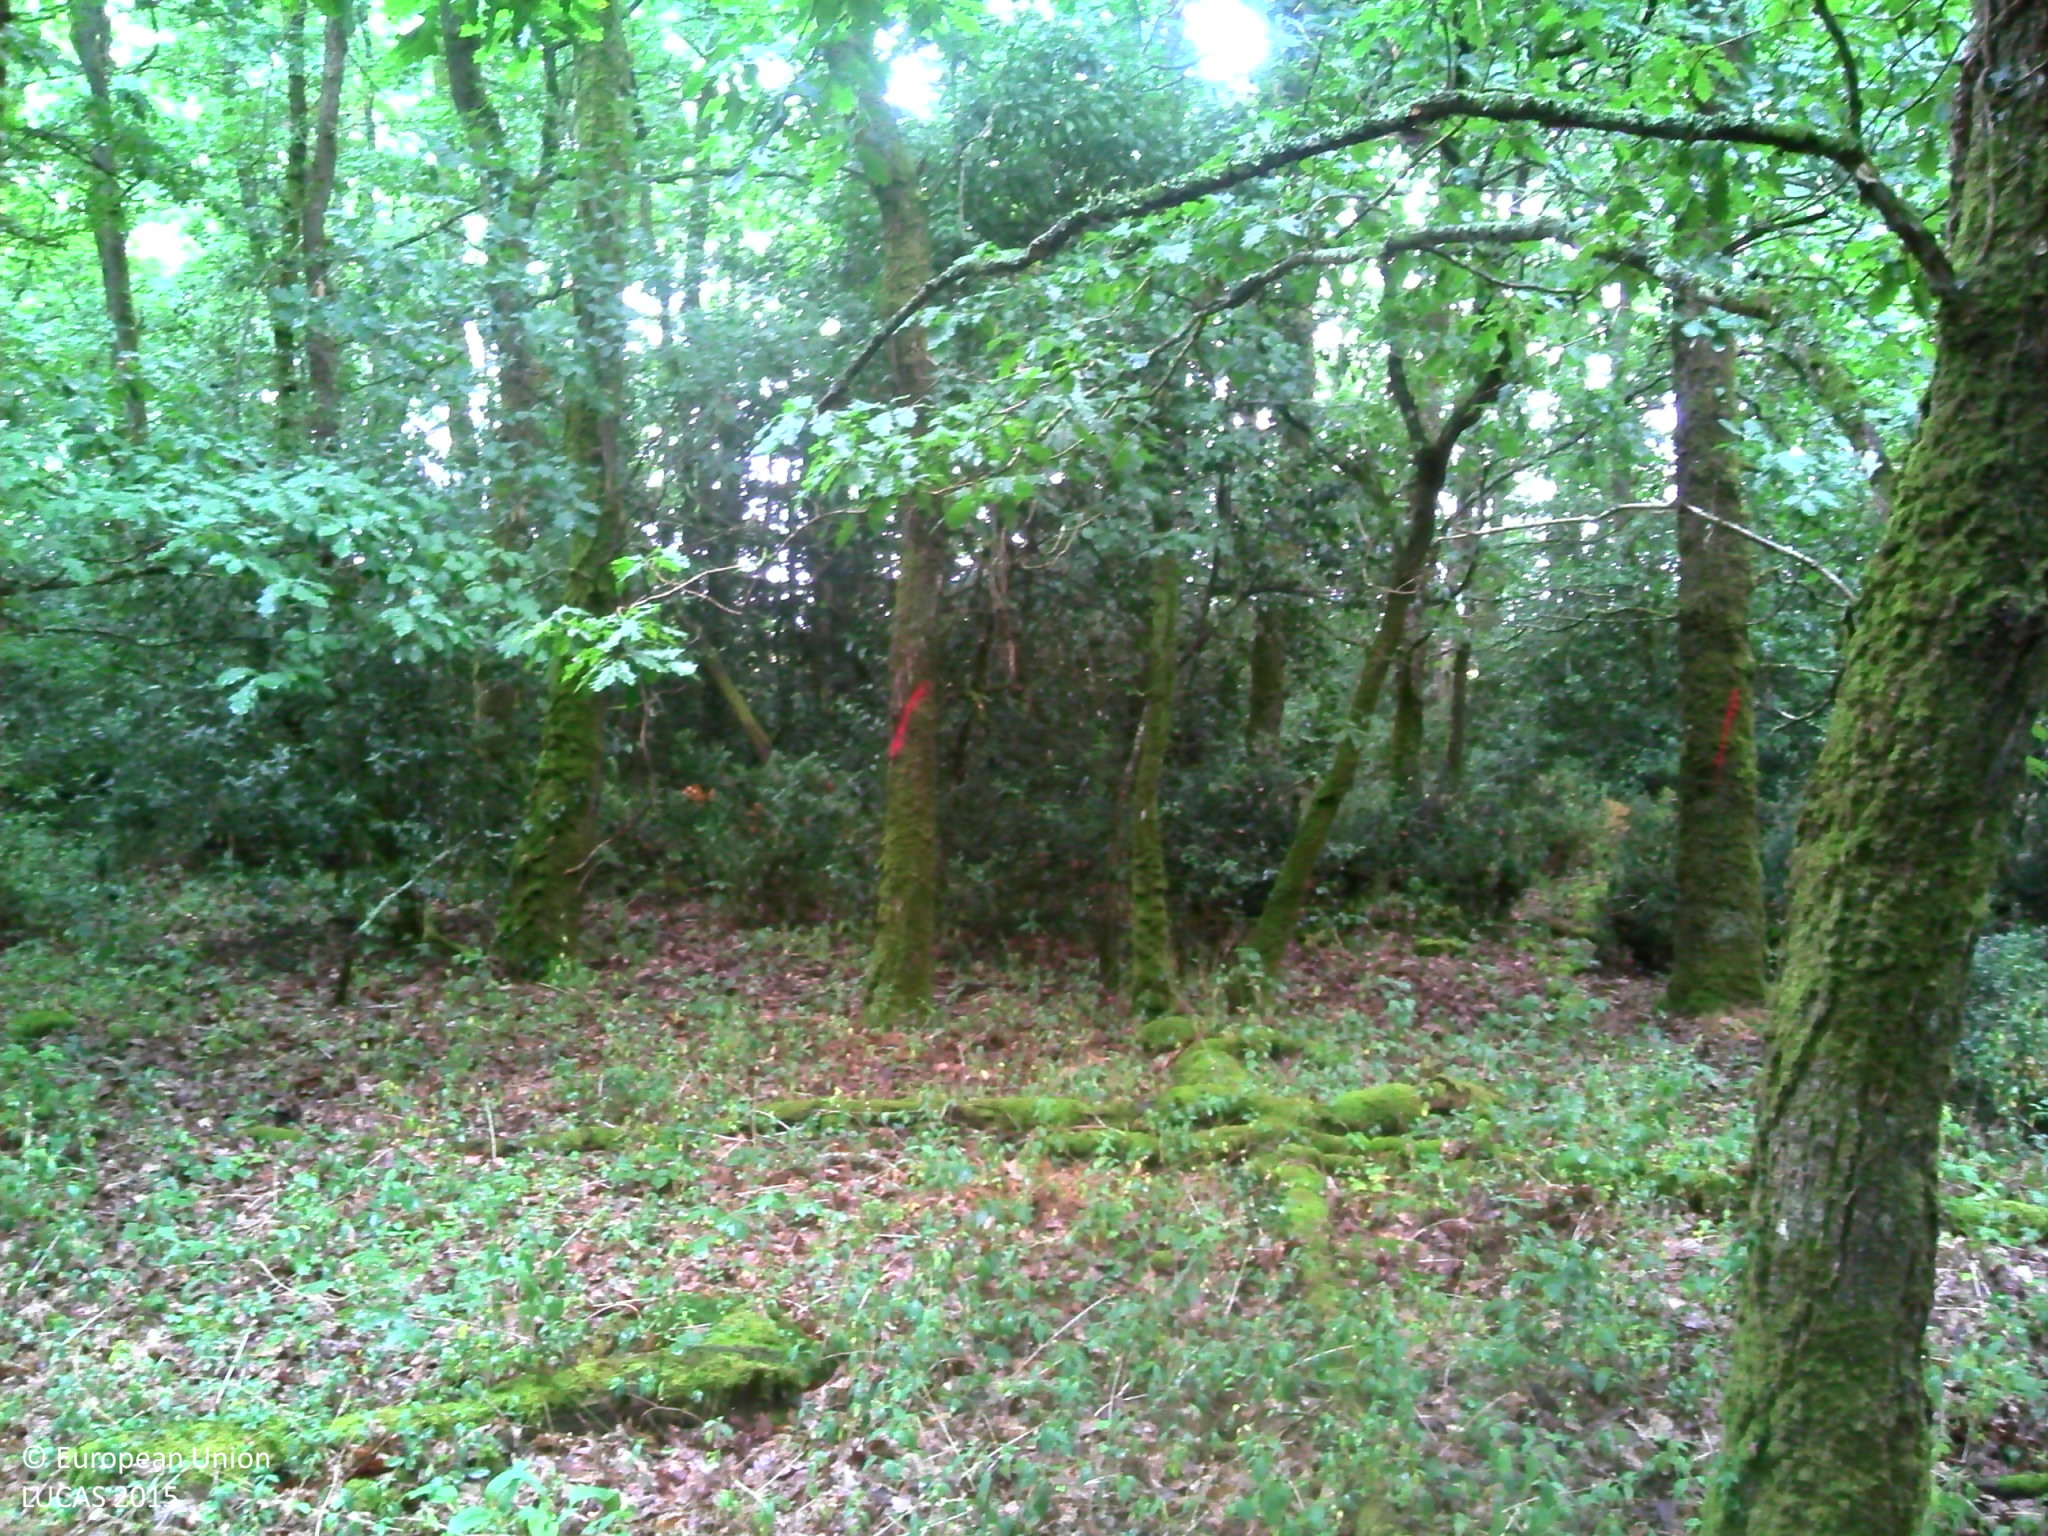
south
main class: Woodland
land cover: Broadleaved woodland
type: acidophilous oak and oak-birch forest
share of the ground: > 75 %
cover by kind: broadleaved forest trees 95 %, herbaceous plants 5 %
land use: Forestry
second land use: Amenities, museums, leisure
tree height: > 5 m
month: July
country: FR
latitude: 47.4969
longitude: -1.7946
